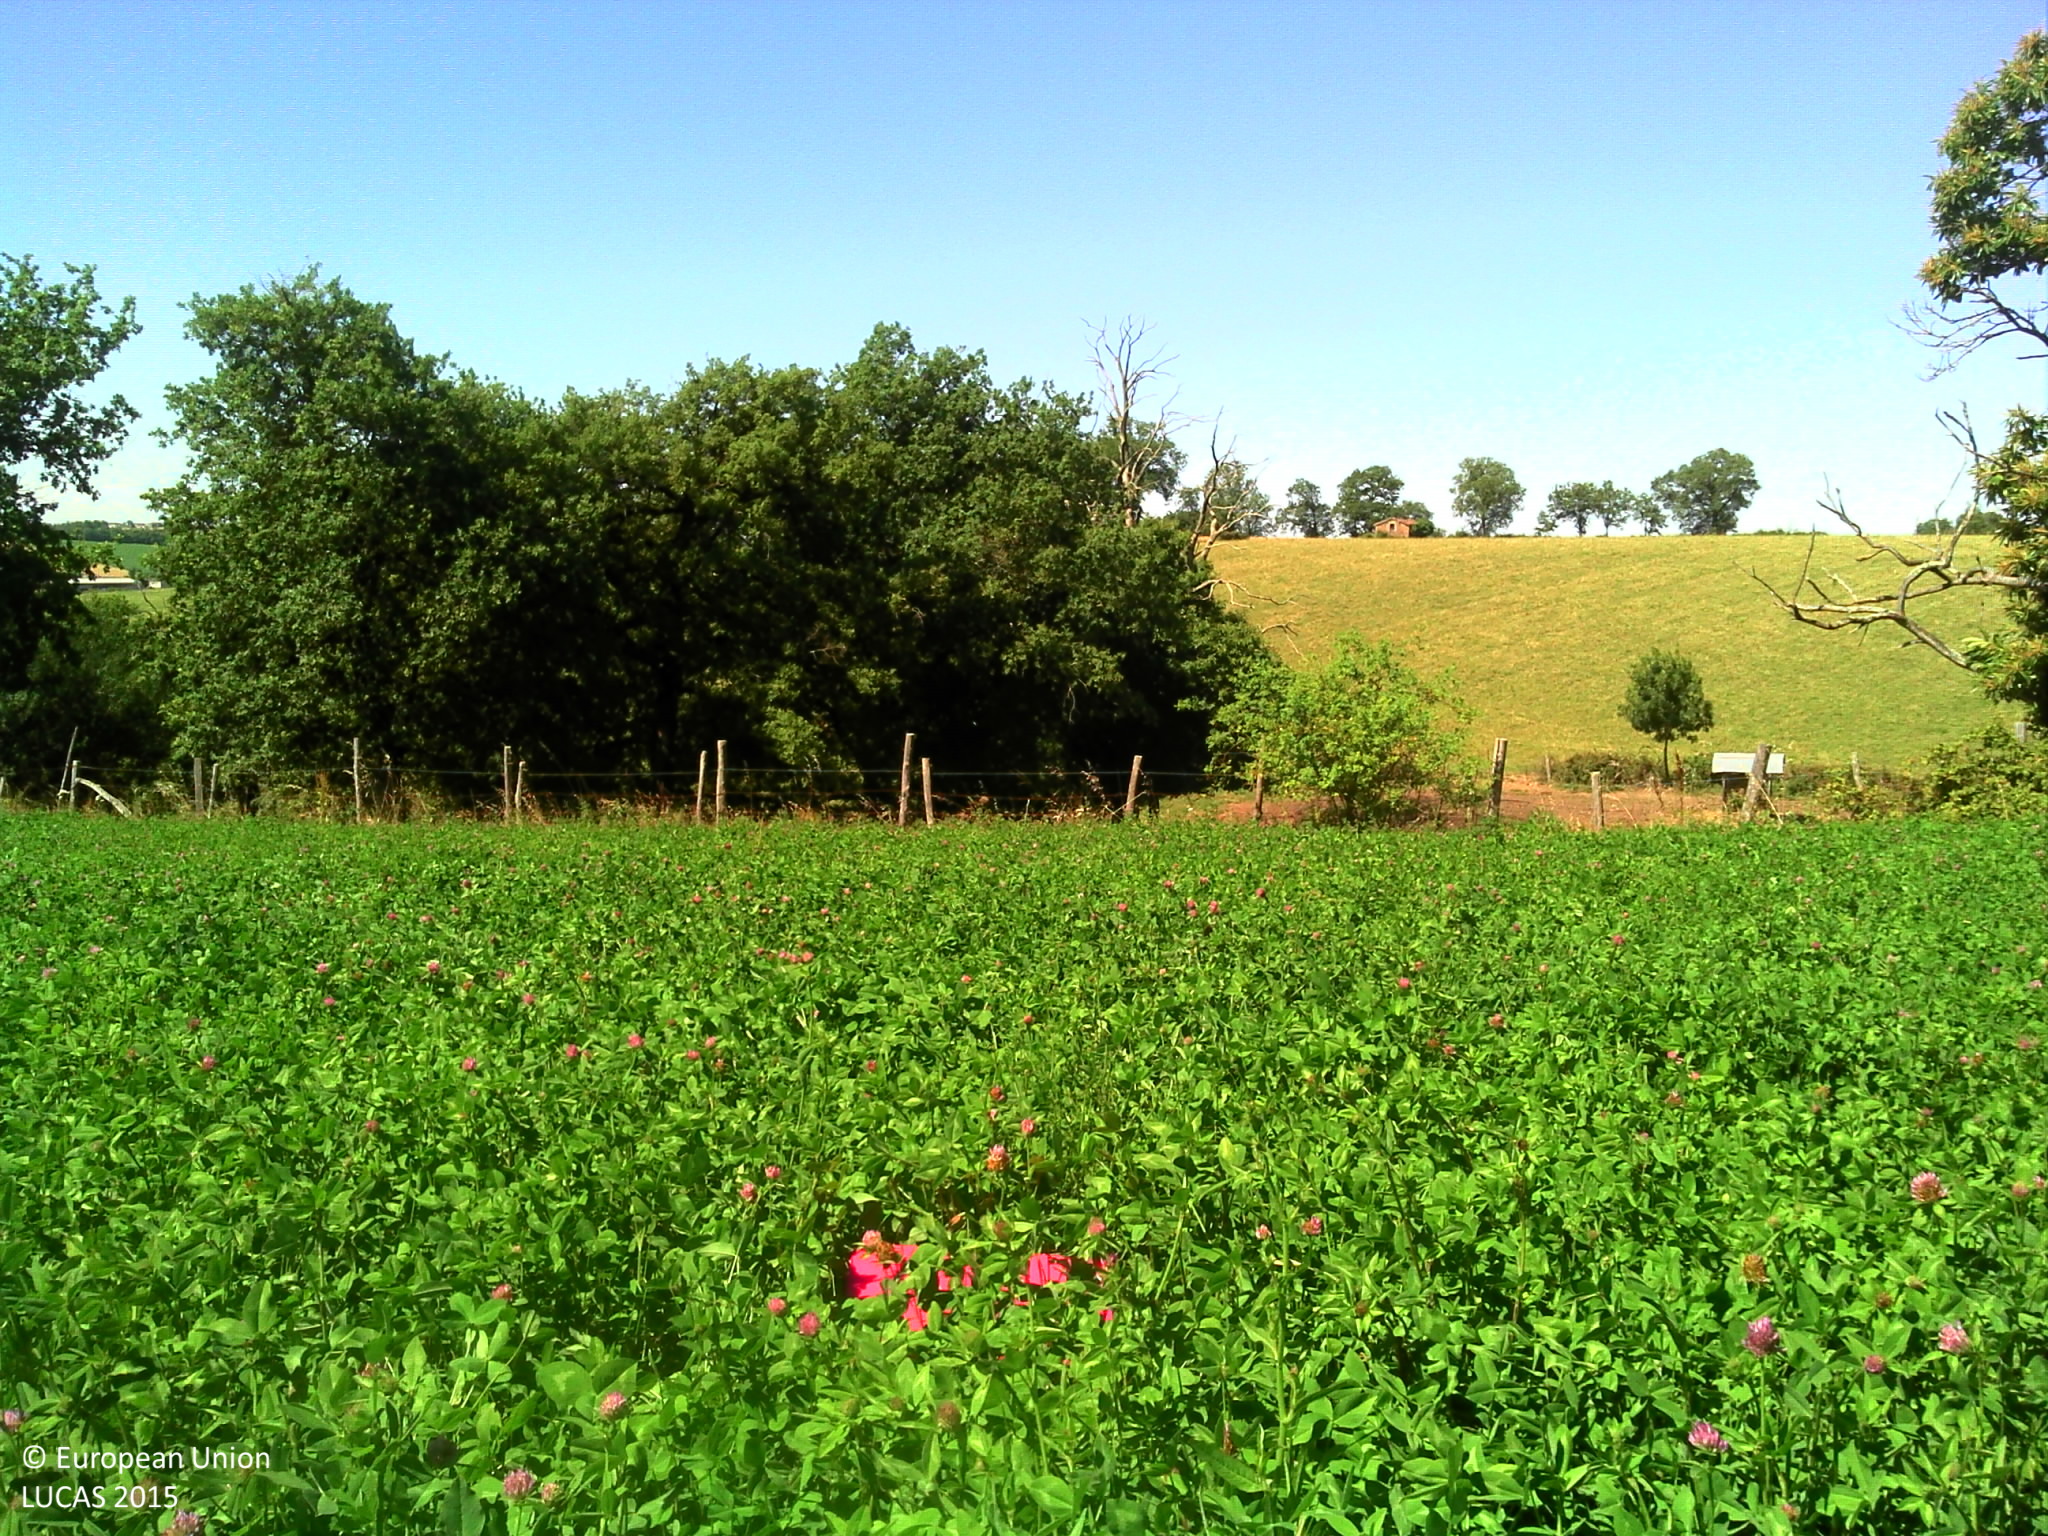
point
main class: Cropland
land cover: Clovers
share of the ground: > 75 %
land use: Agriculture (excluding fallow land and kitchen gardens)
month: June
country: FR
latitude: 44.0832
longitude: 2.0727
